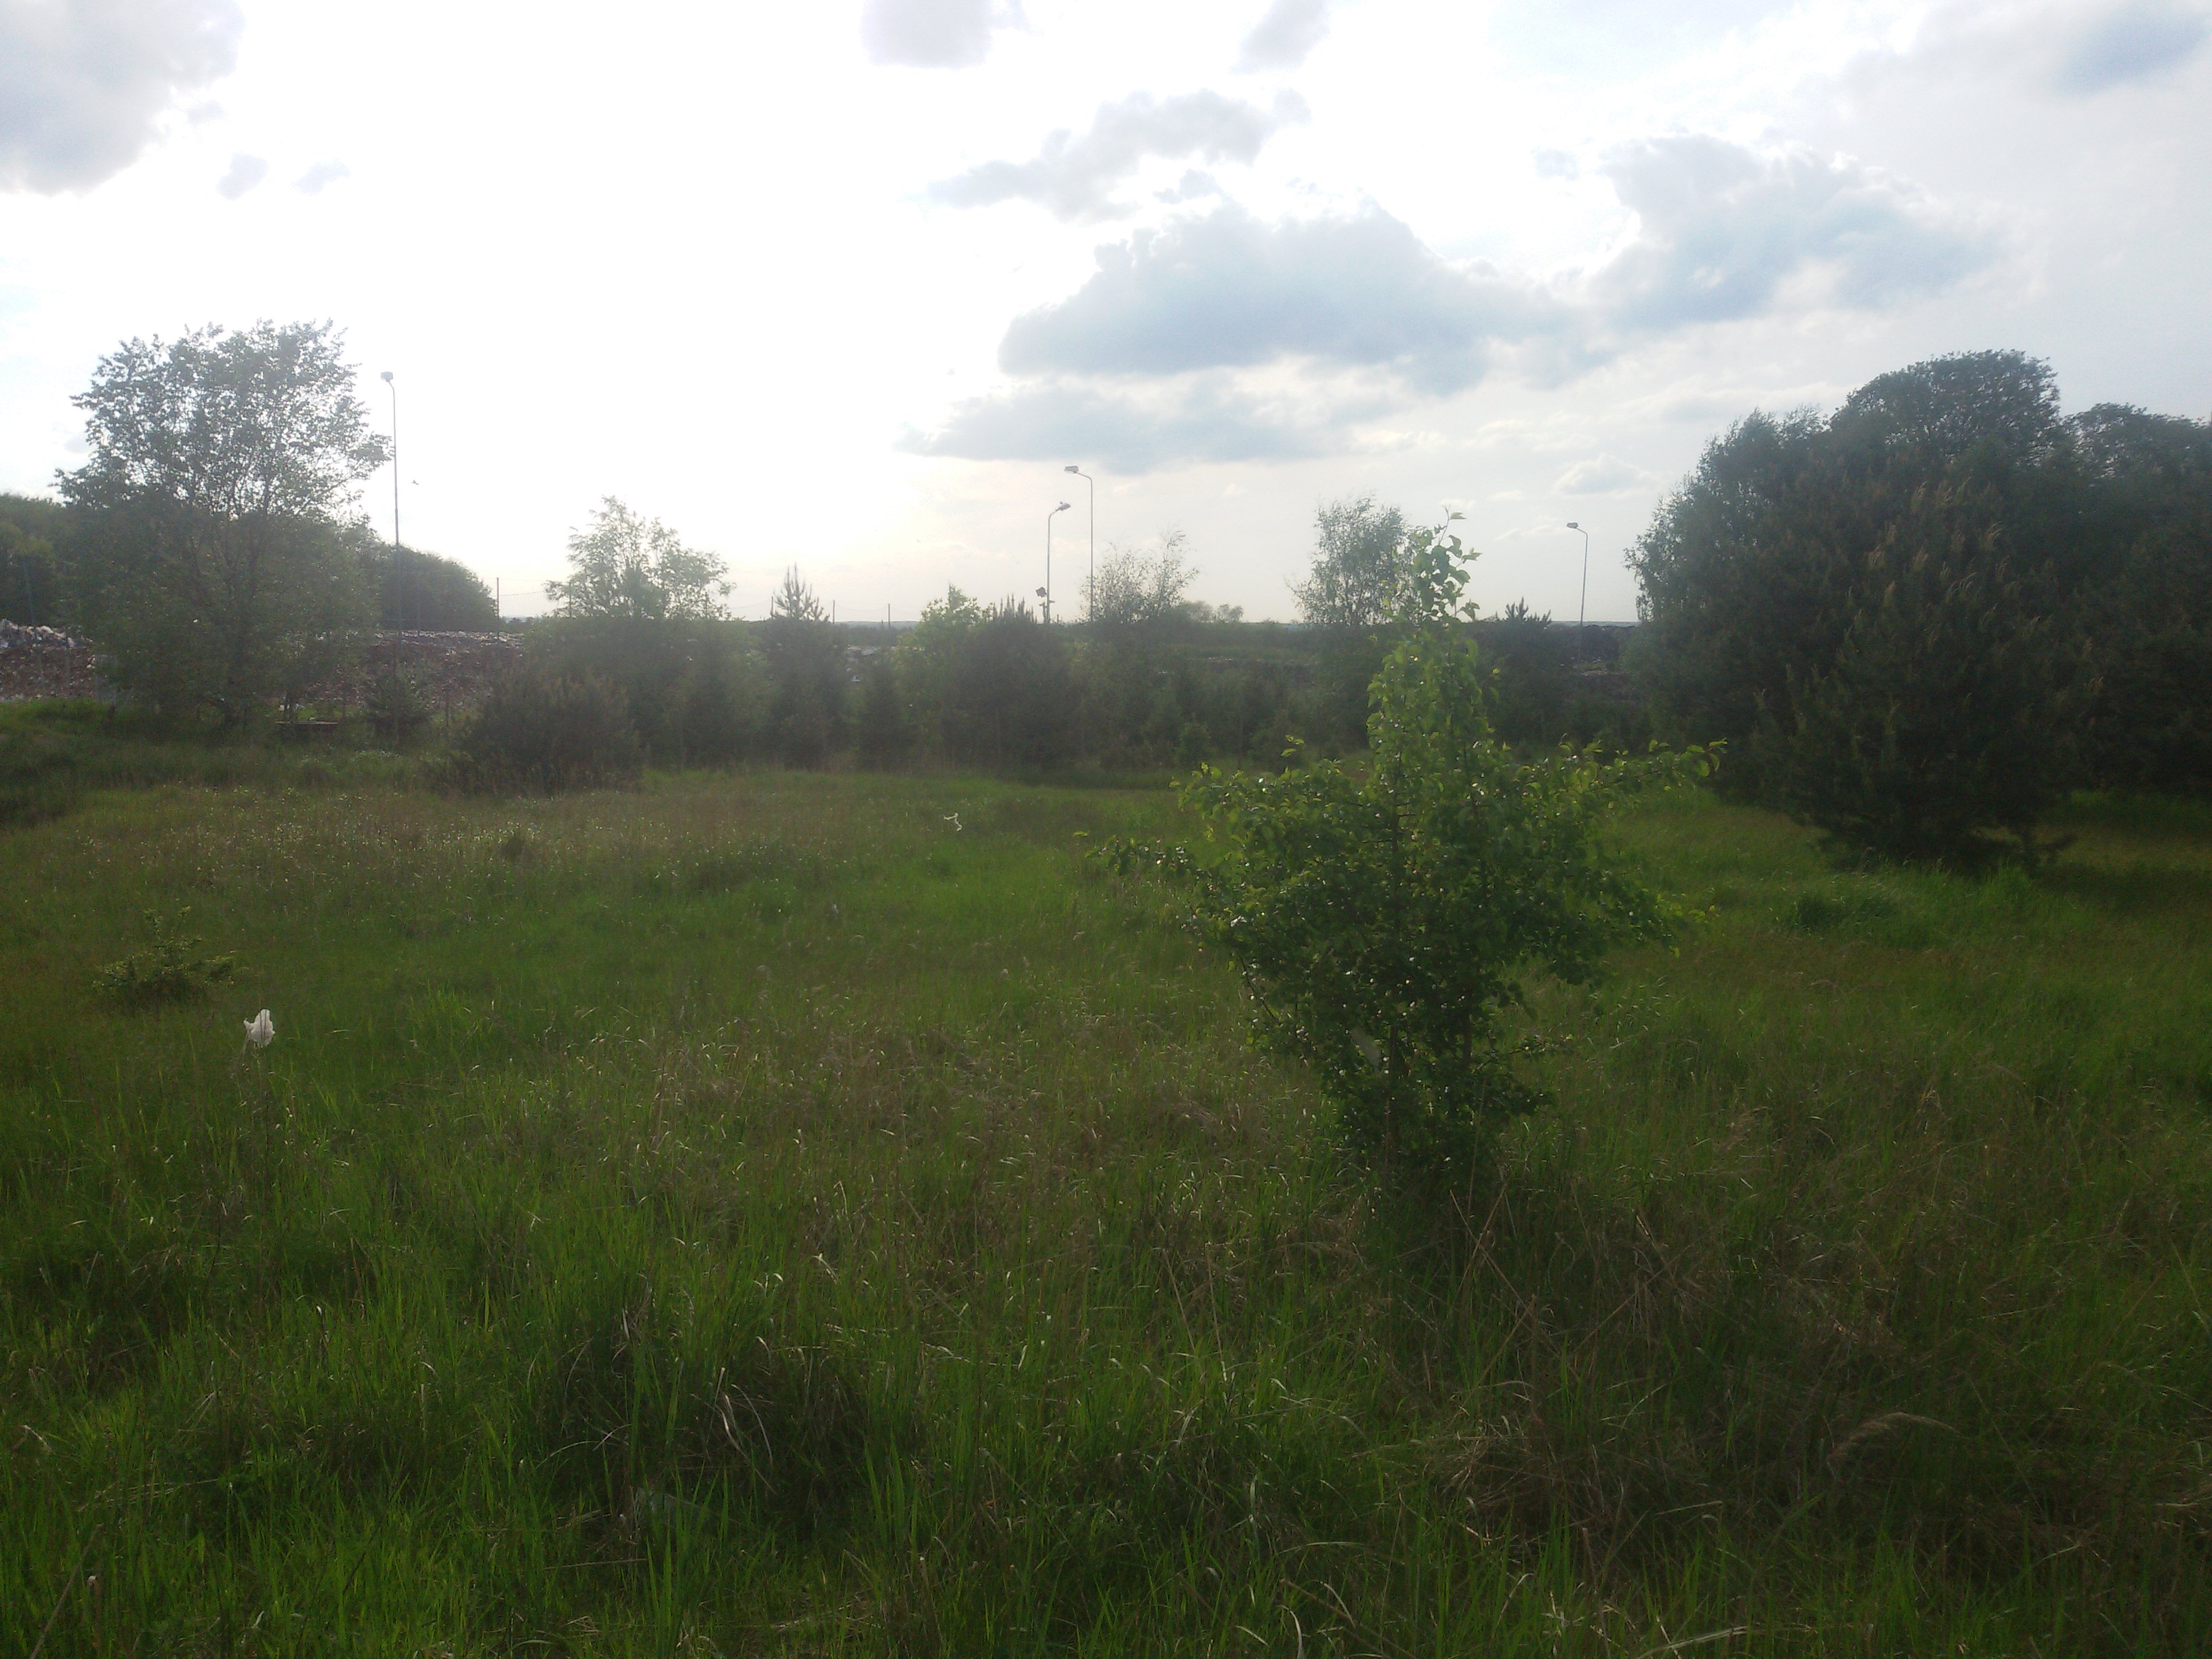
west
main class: Grassland
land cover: Grassland with sparse tree/shrub cover
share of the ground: > 75 %
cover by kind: herbaceous plants 95 %, coniferous forest trees 5 %
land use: Semi-natural and natural areas not in use
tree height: < 5 m
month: May
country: PL
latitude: 53.5160
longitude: 14.5103
